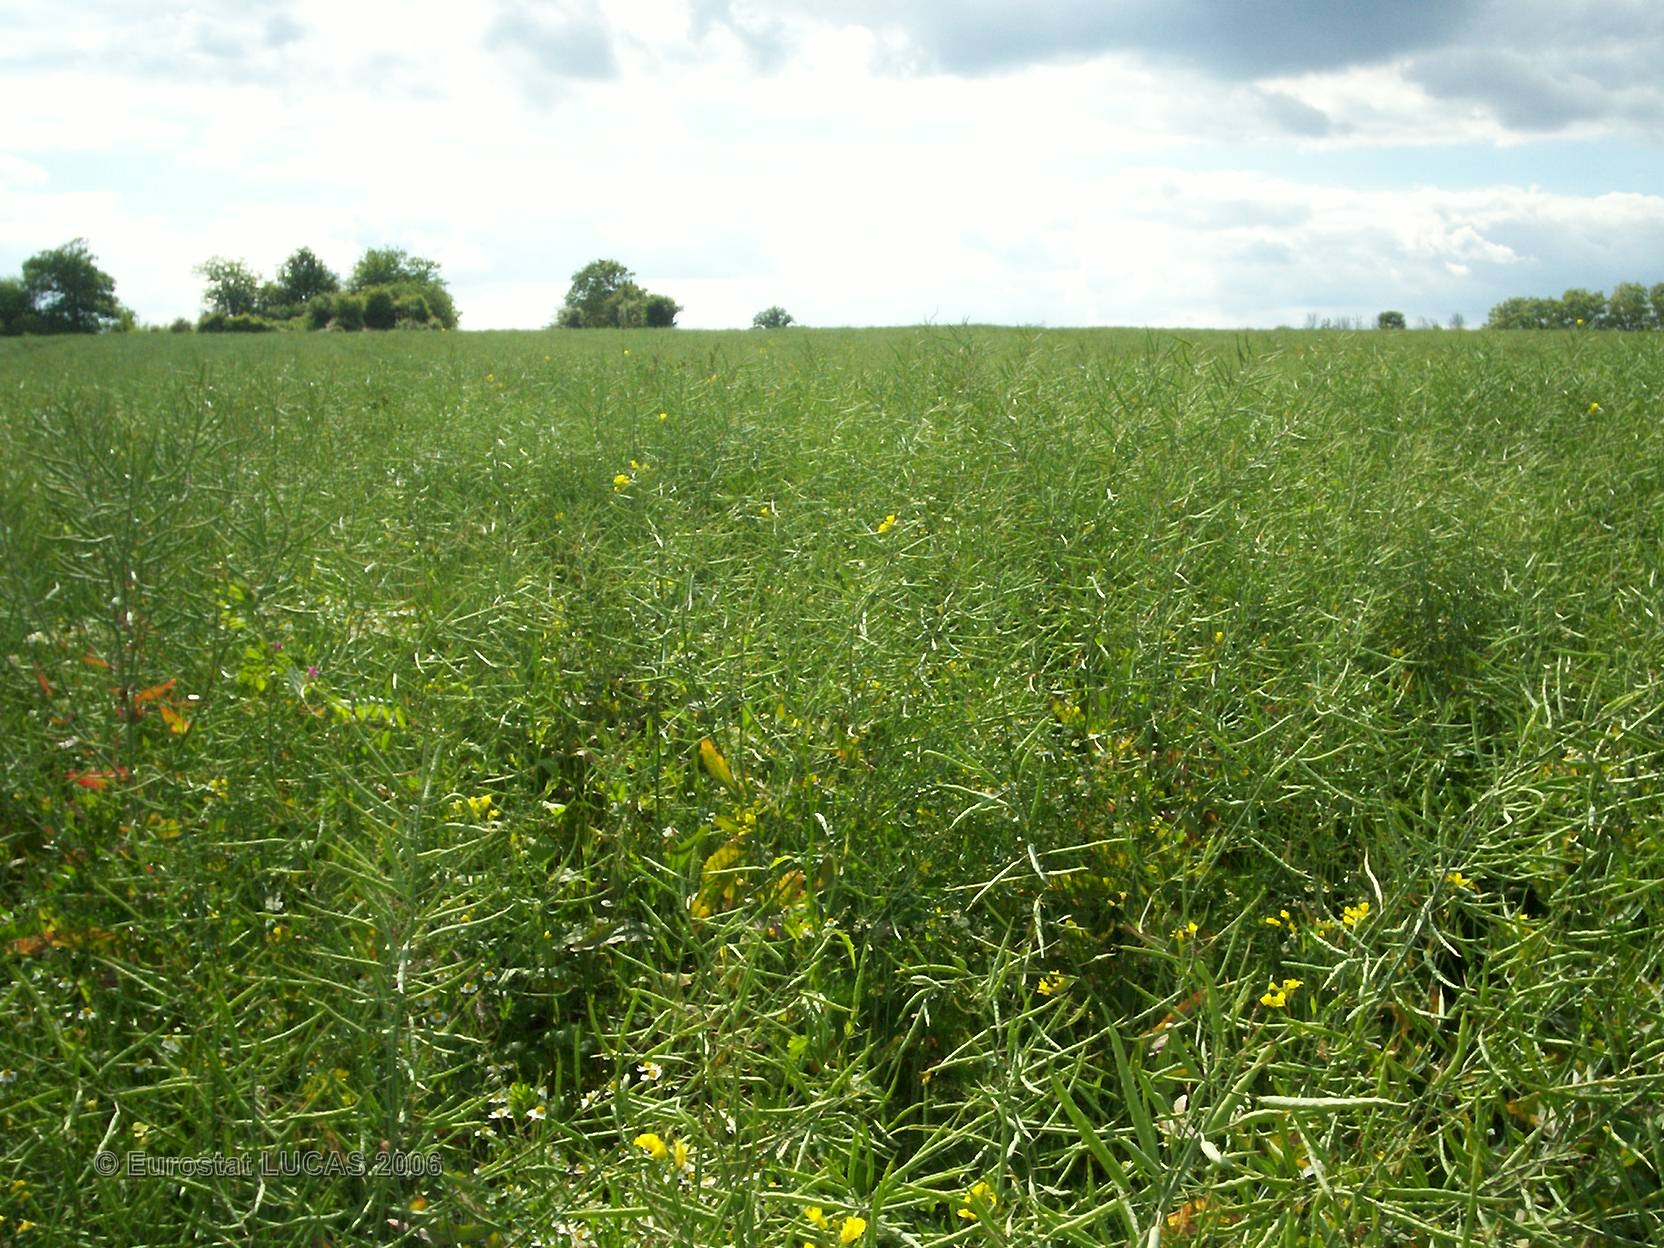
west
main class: Cropland
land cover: Rape and turnip rape
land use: Agriculture (excluding fallow land and kitchen gardens)
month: June
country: FR
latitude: 47.1156
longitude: 2.9970
